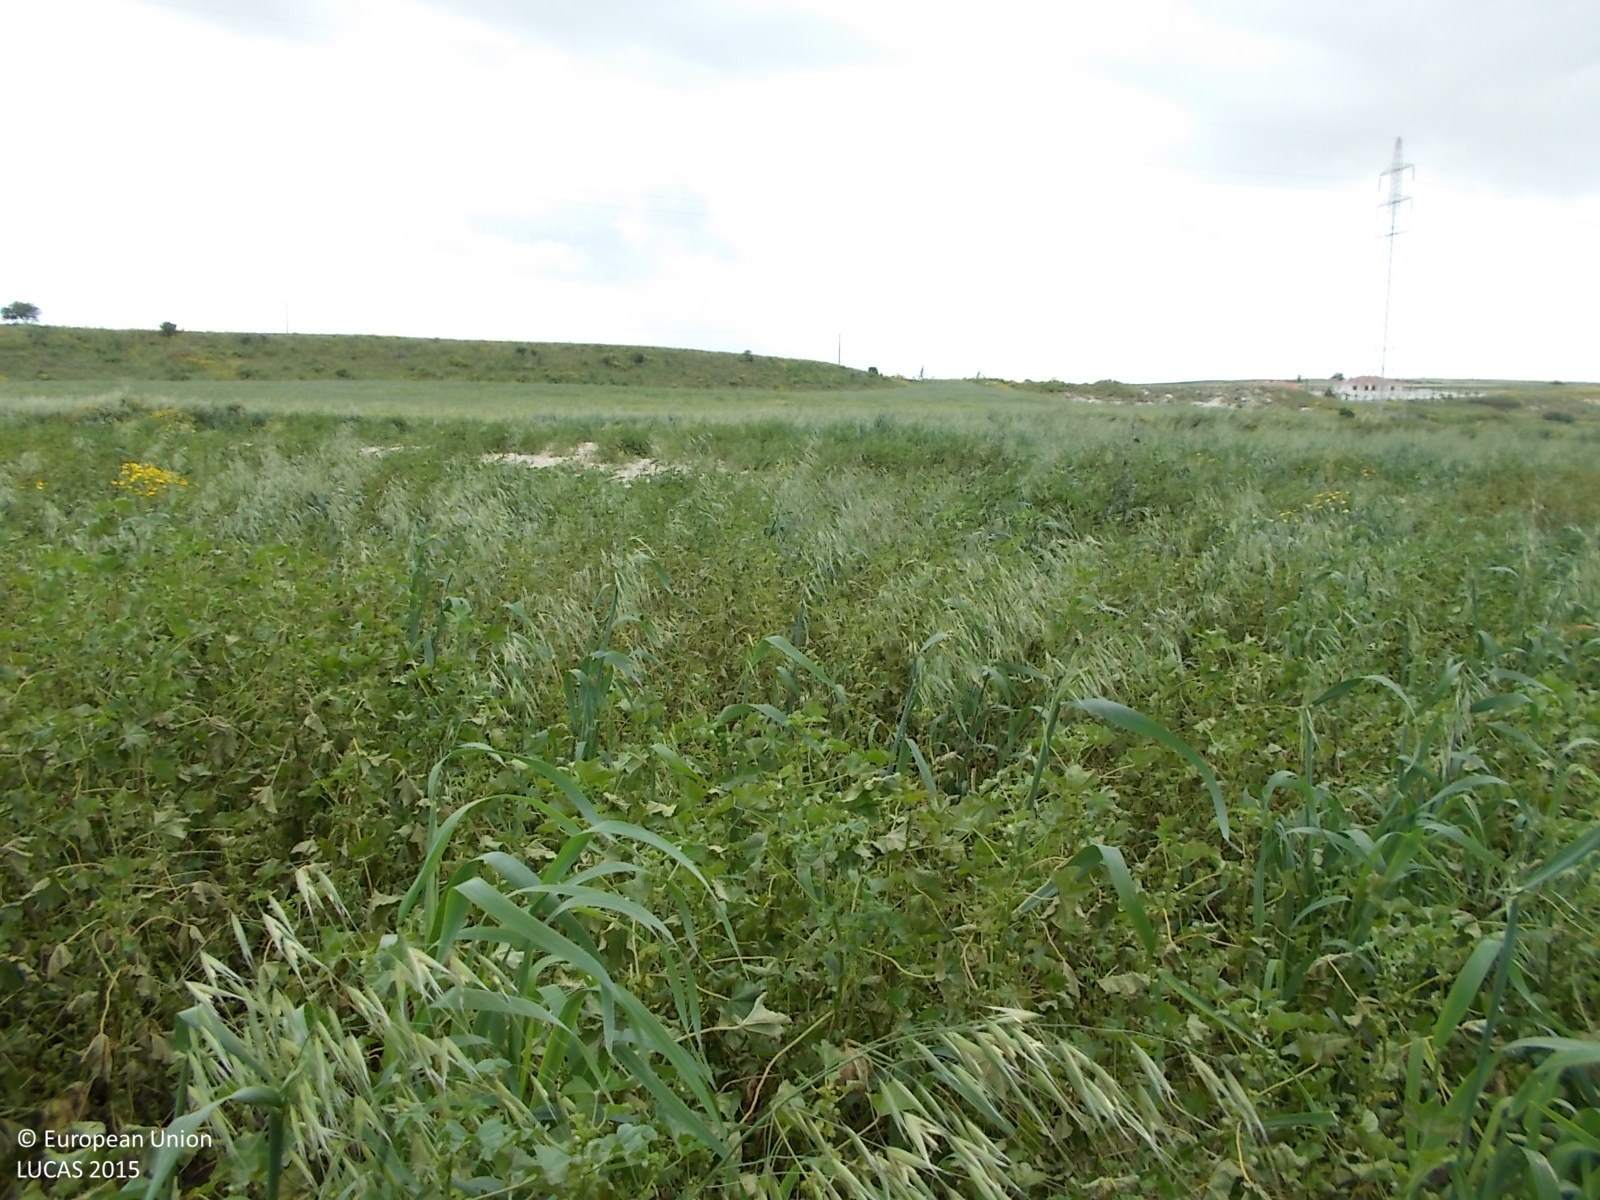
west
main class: Cropland
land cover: Other fresh vegetables
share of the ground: > 75 %
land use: Agriculture (excluding fallow land and kitchen gardens)
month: April
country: CY
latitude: 34.9115
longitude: 33.5609
